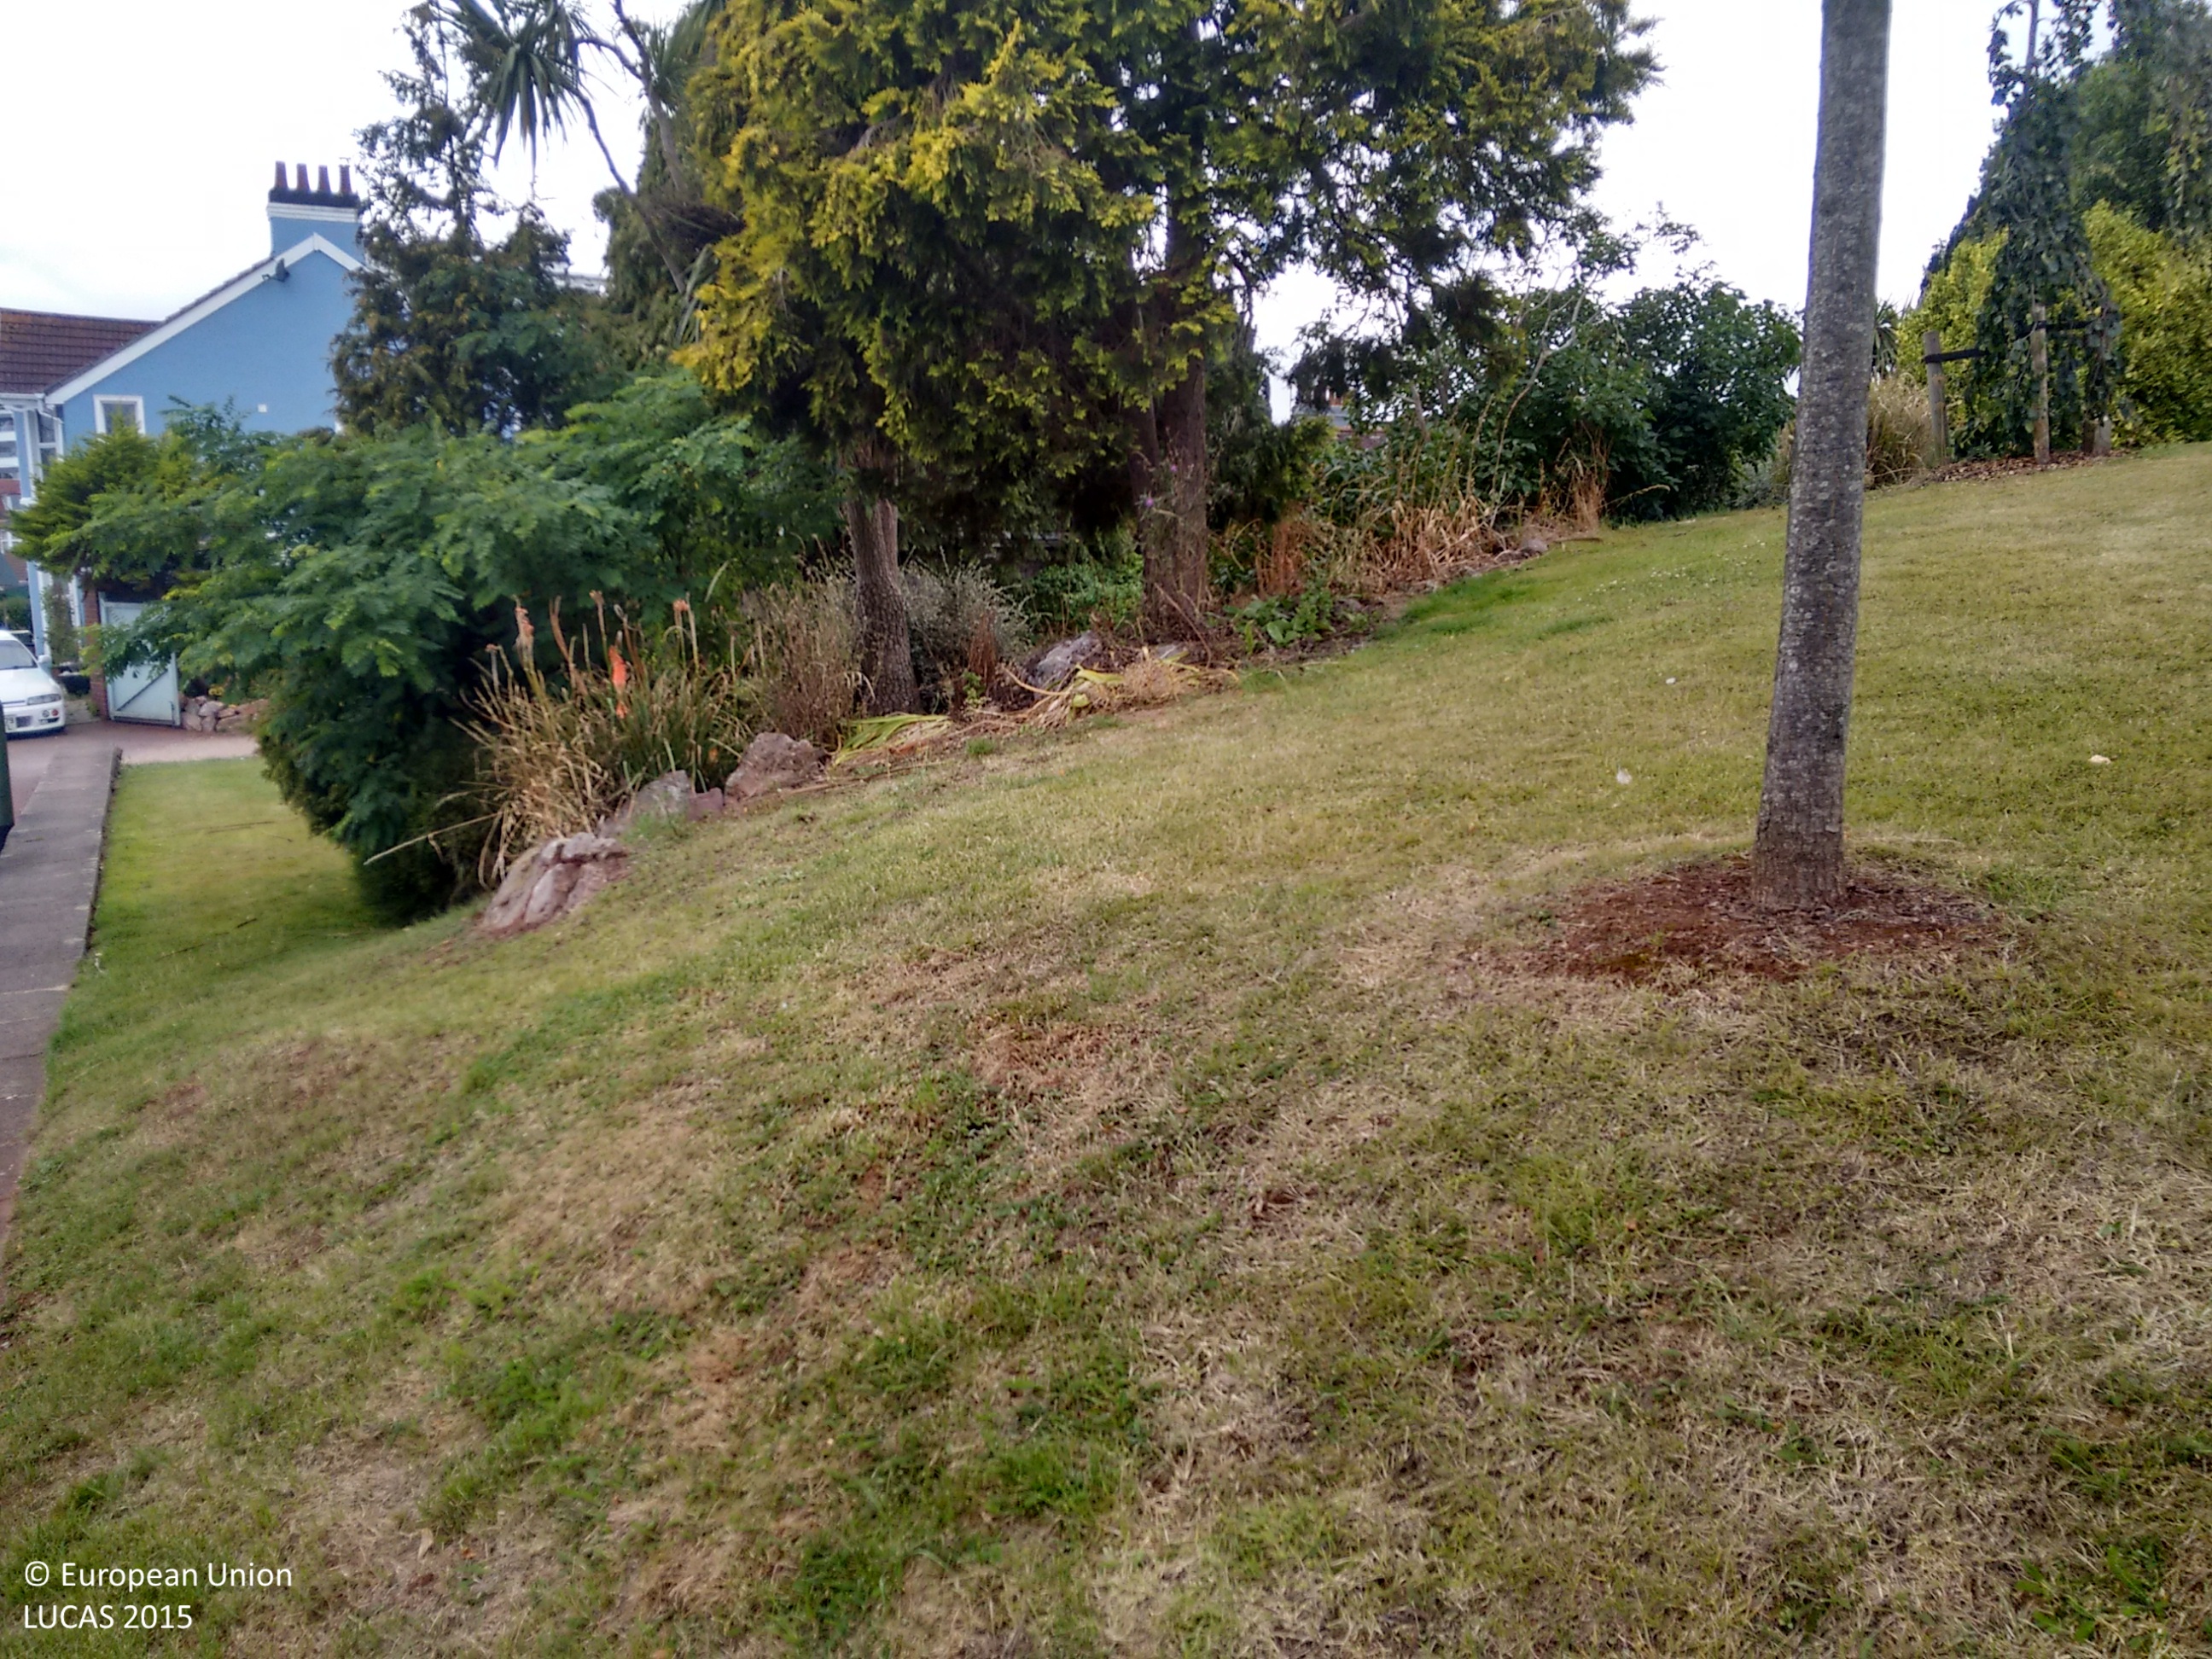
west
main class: Grassland
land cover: Grassland with sparse tree/shrub cover
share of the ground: > 75 %
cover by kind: herbaceous plants 95 %, broadleaved forest trees 5 %
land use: Amenities, museums, leisure
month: July
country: GB
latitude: 50.4453
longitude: -3.5613
